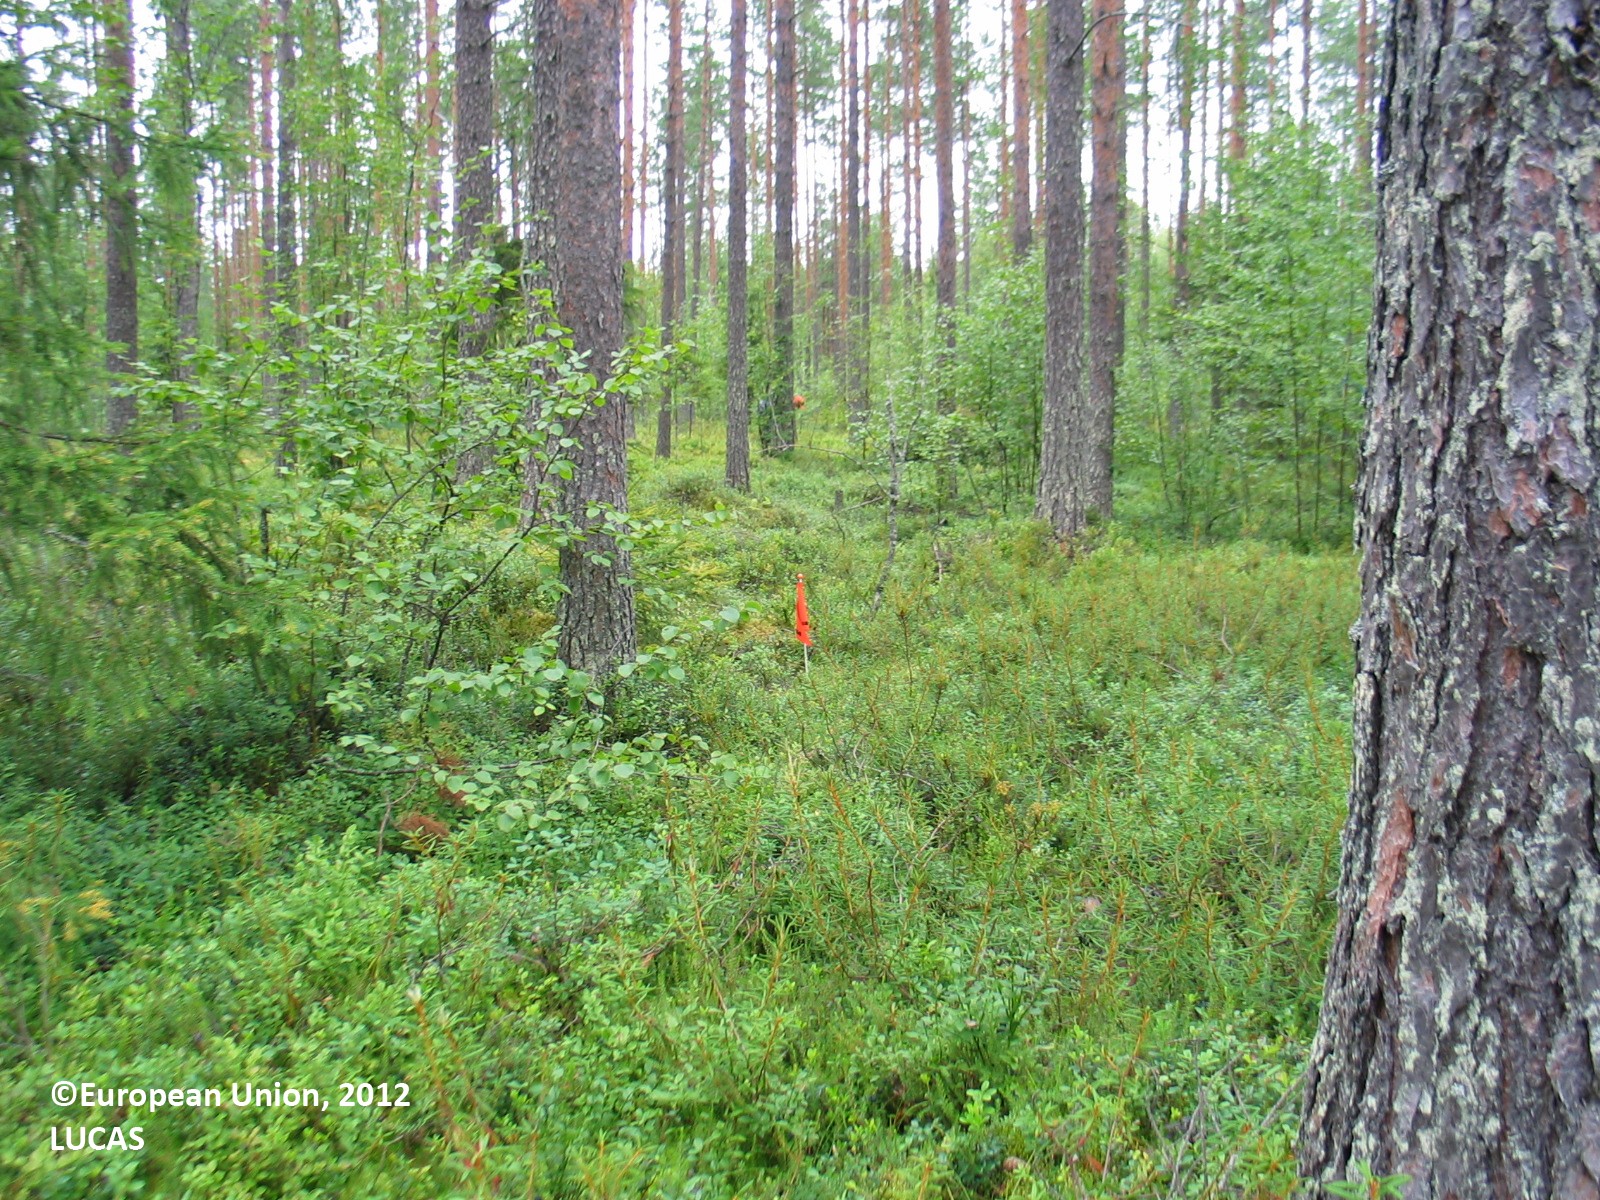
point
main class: Woodland
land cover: Pine dominated coniferous woodland
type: boreal forest
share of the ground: 25 - 50 %
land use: Forestry
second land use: Amenities, museums, leisure
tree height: > 5 m
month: August
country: FI
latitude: 65.0939
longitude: 25.4684
